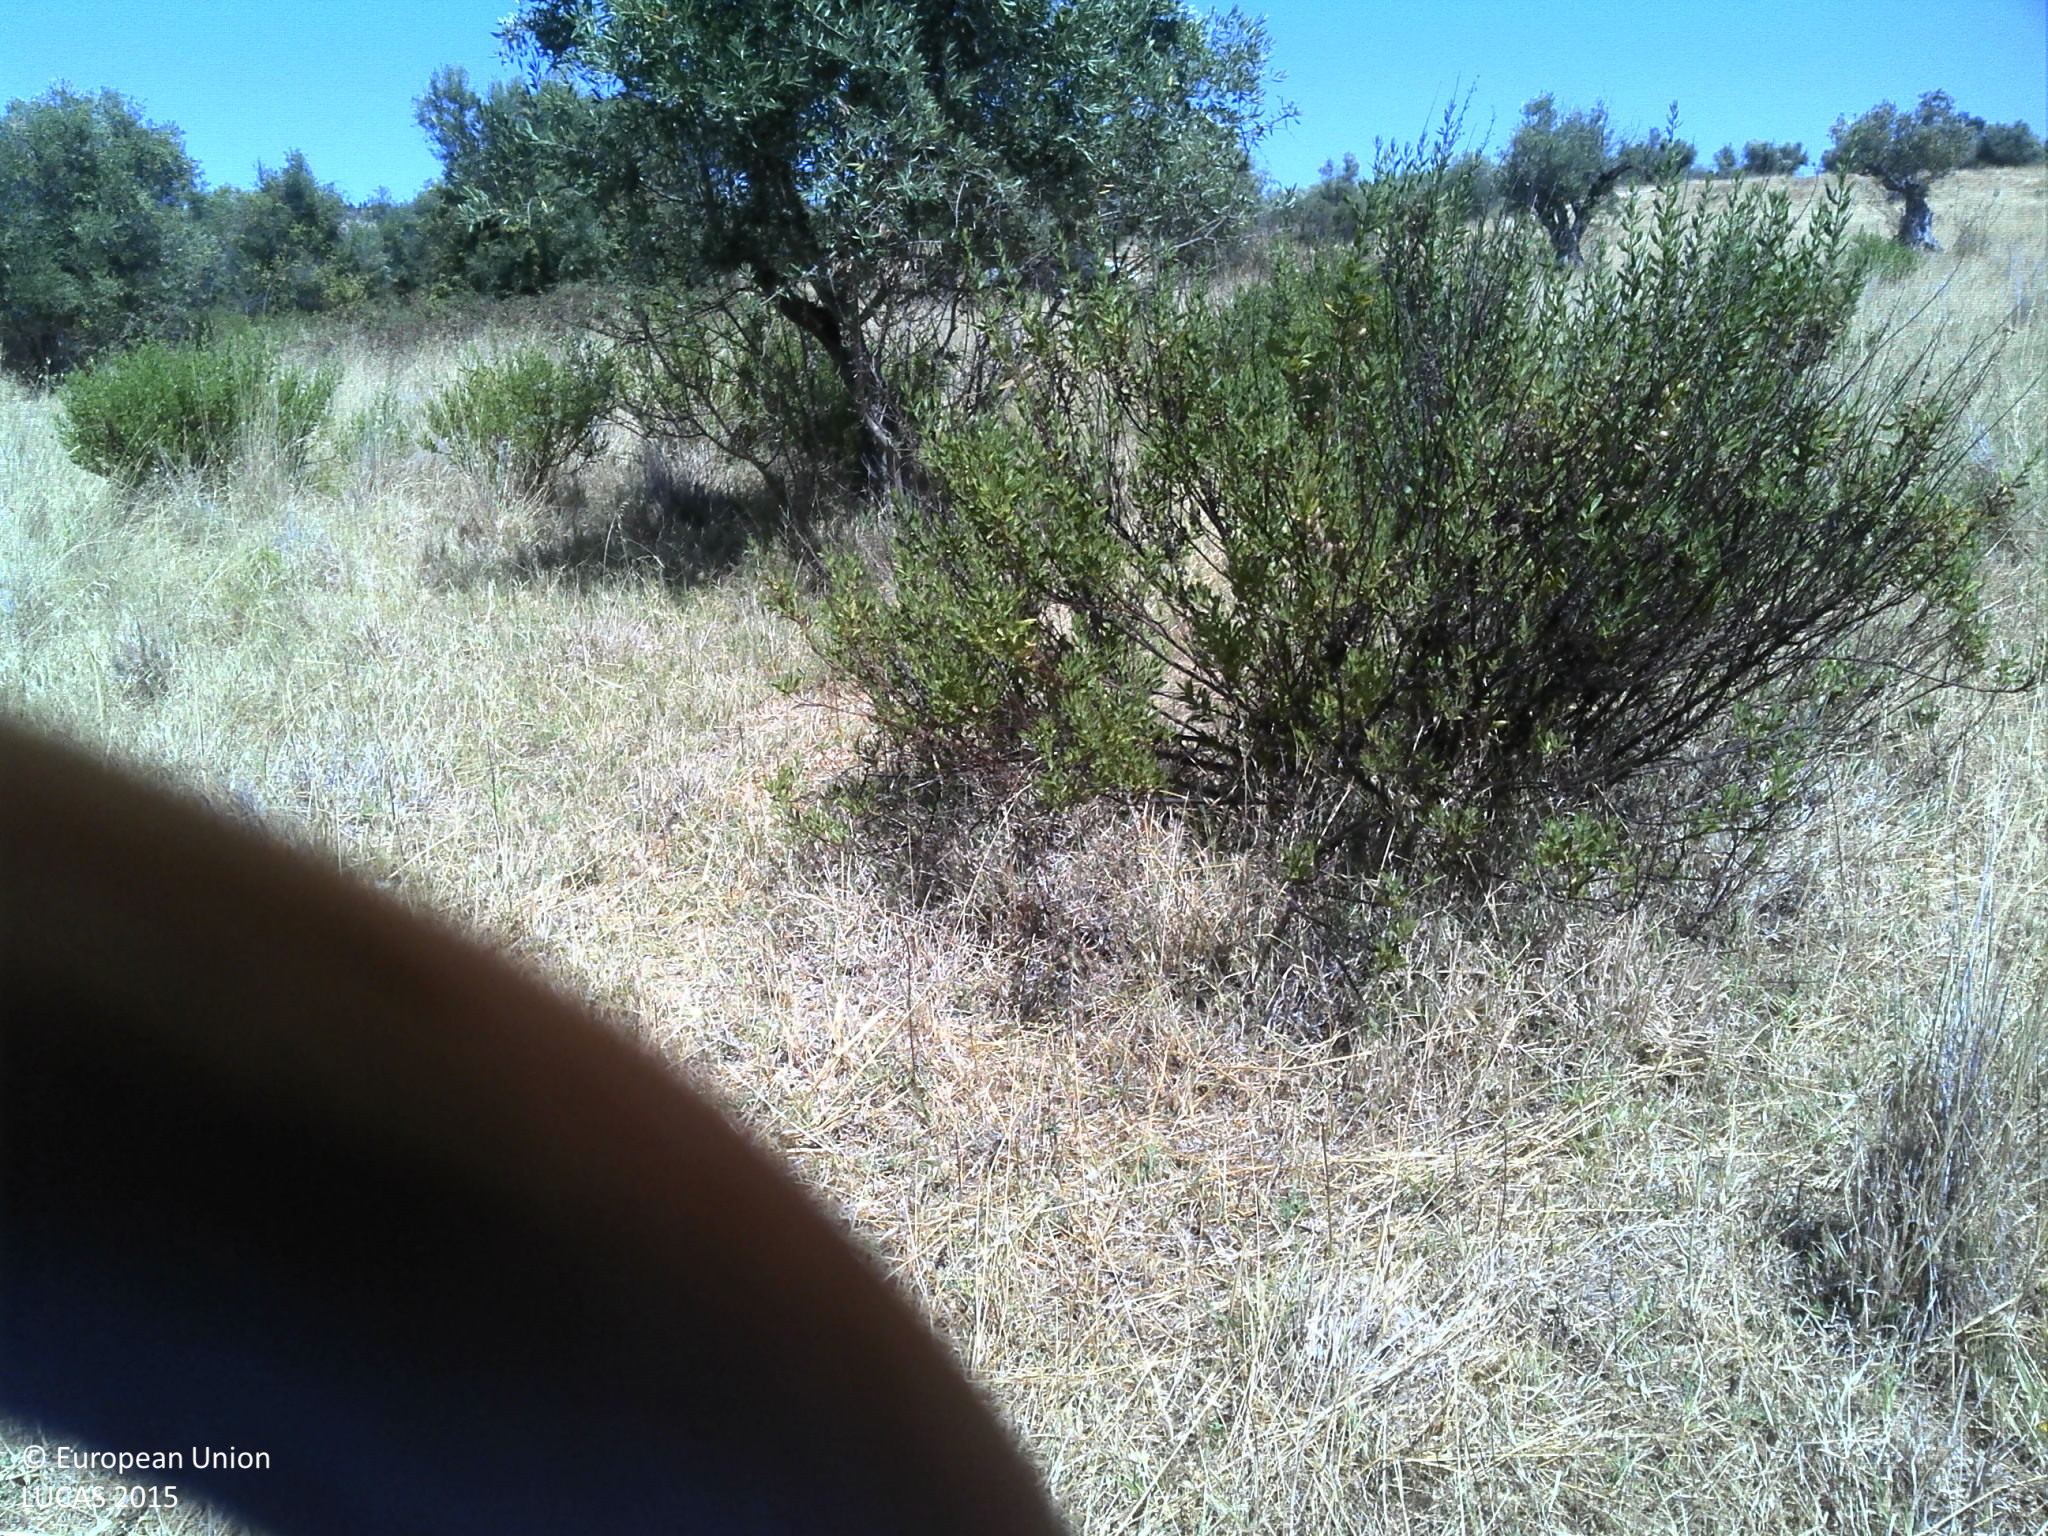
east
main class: Cropland
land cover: Olive groves
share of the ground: 25 - 50 %
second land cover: Grassland without tree/shrub cover
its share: 25 - 50 %
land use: Agriculture (excluding fallow land and kitchen gardens)
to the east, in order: Olive groves; Grassland without tree/shrub cover; Olive groves; Tracks; Olive groves; Other fruit trees and berries; Olive groves; Fences; Ditches and canals; Olive groves; Fences; Other structural elements; Vineyards
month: July
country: PT
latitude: 38.2063
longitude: -7.7645
